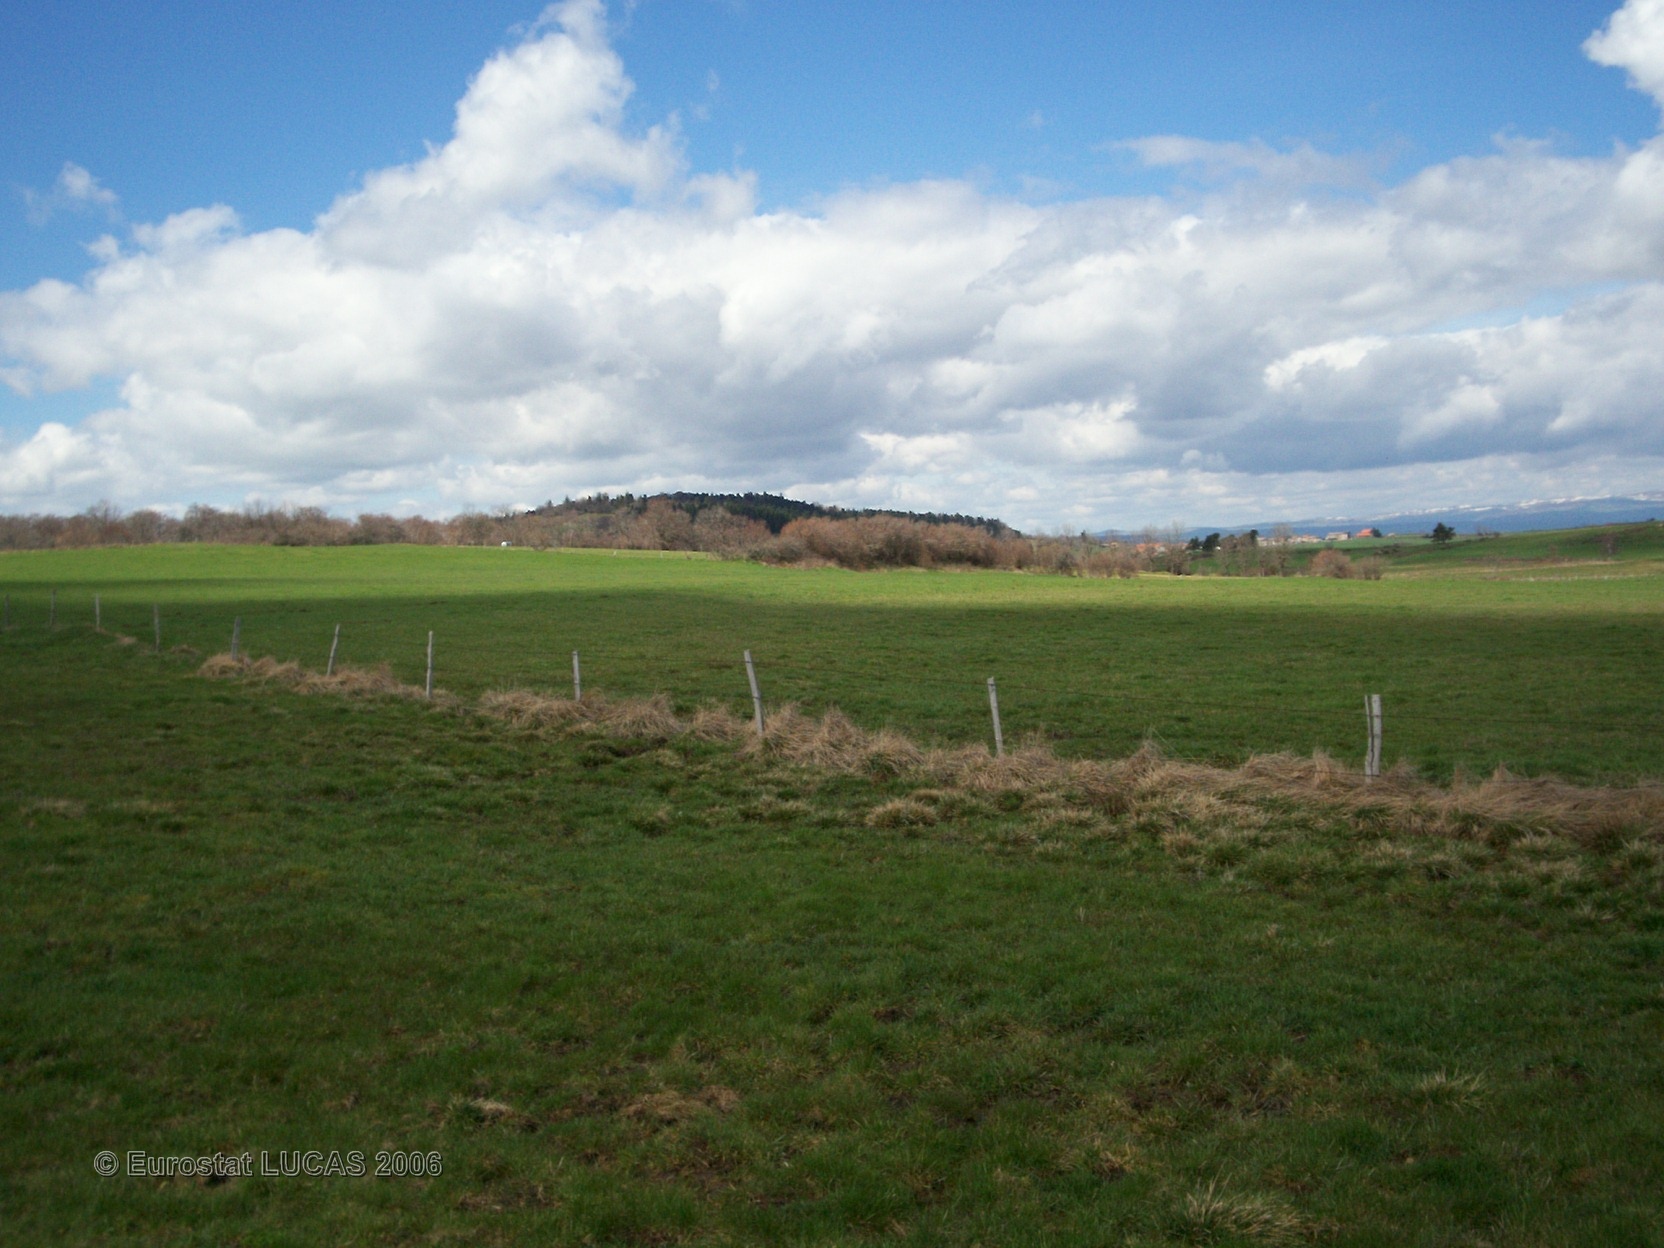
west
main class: Grassland
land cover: Grassland without tree/shrub cover
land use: Agriculture (excluding fallow land and kitchen gardens)
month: April
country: FR
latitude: 45.1077
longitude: 3.2536
